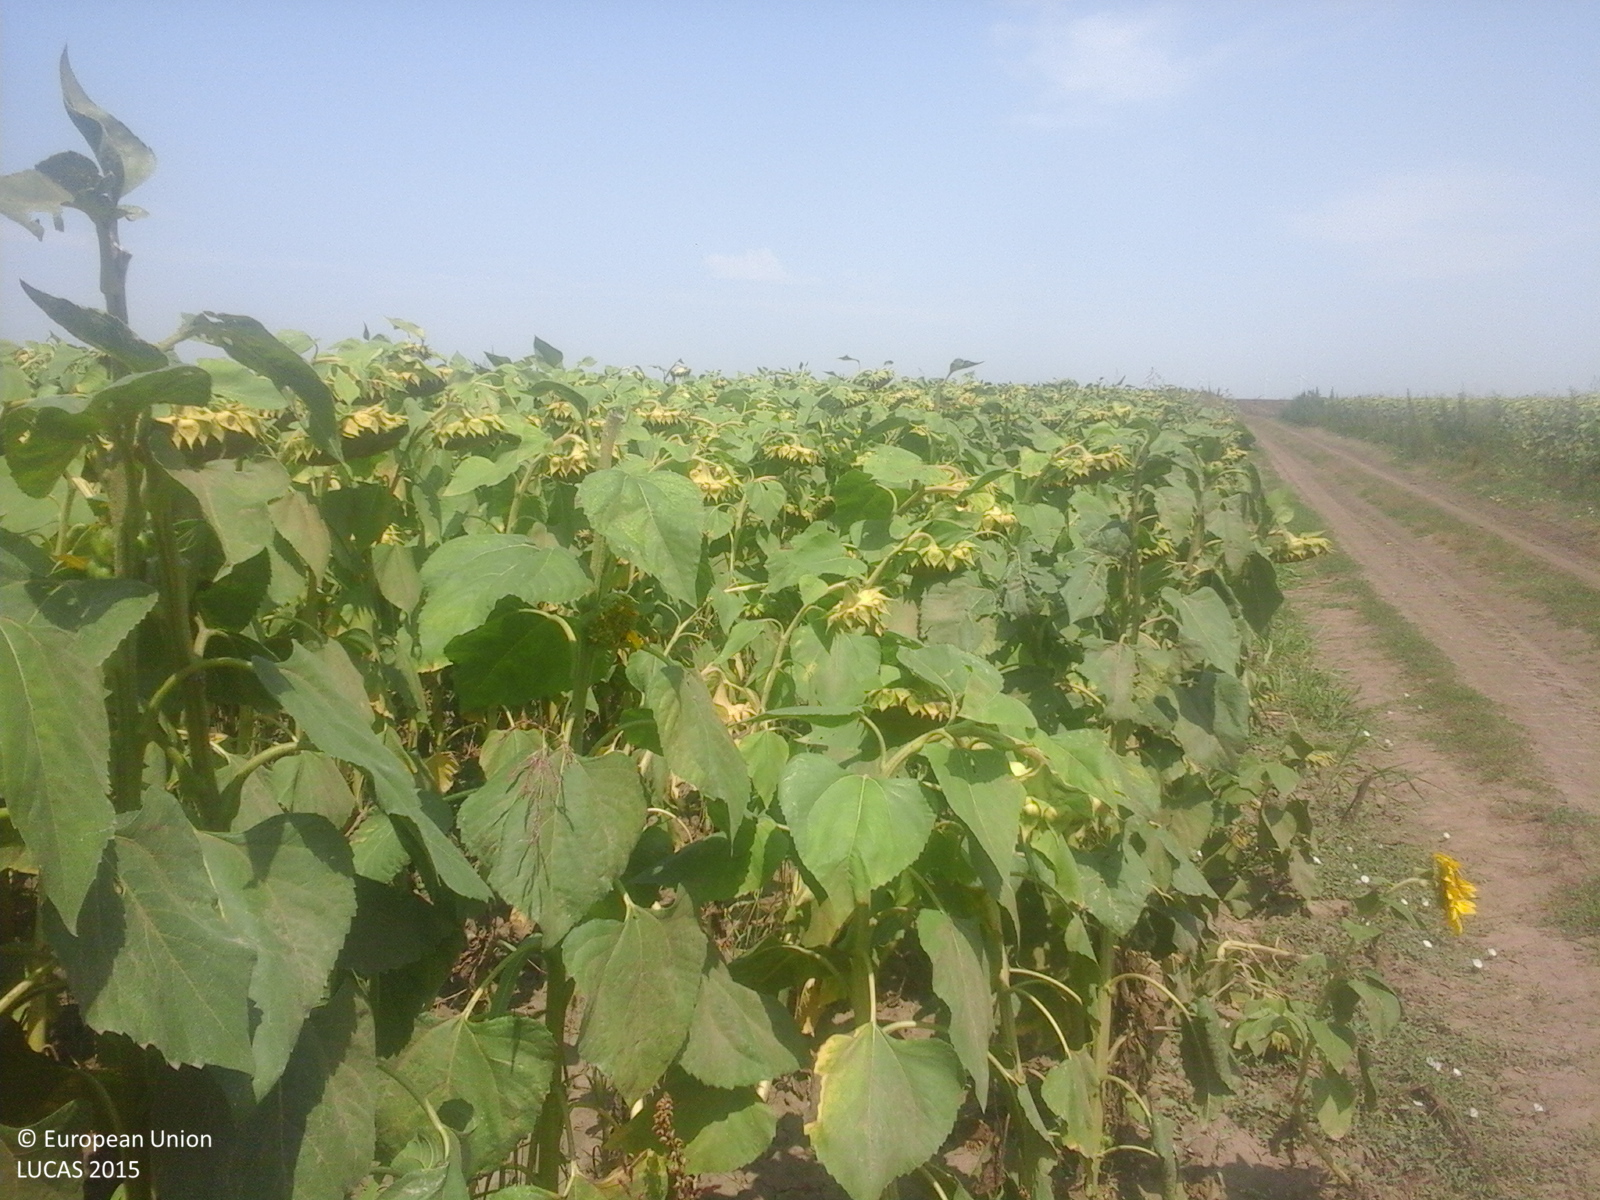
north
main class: Cropland
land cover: Sunflower
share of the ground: > 75 %
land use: Agriculture (excluding fallow land and kitchen gardens)
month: August
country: RO
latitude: 43.8359
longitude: 28.1759
